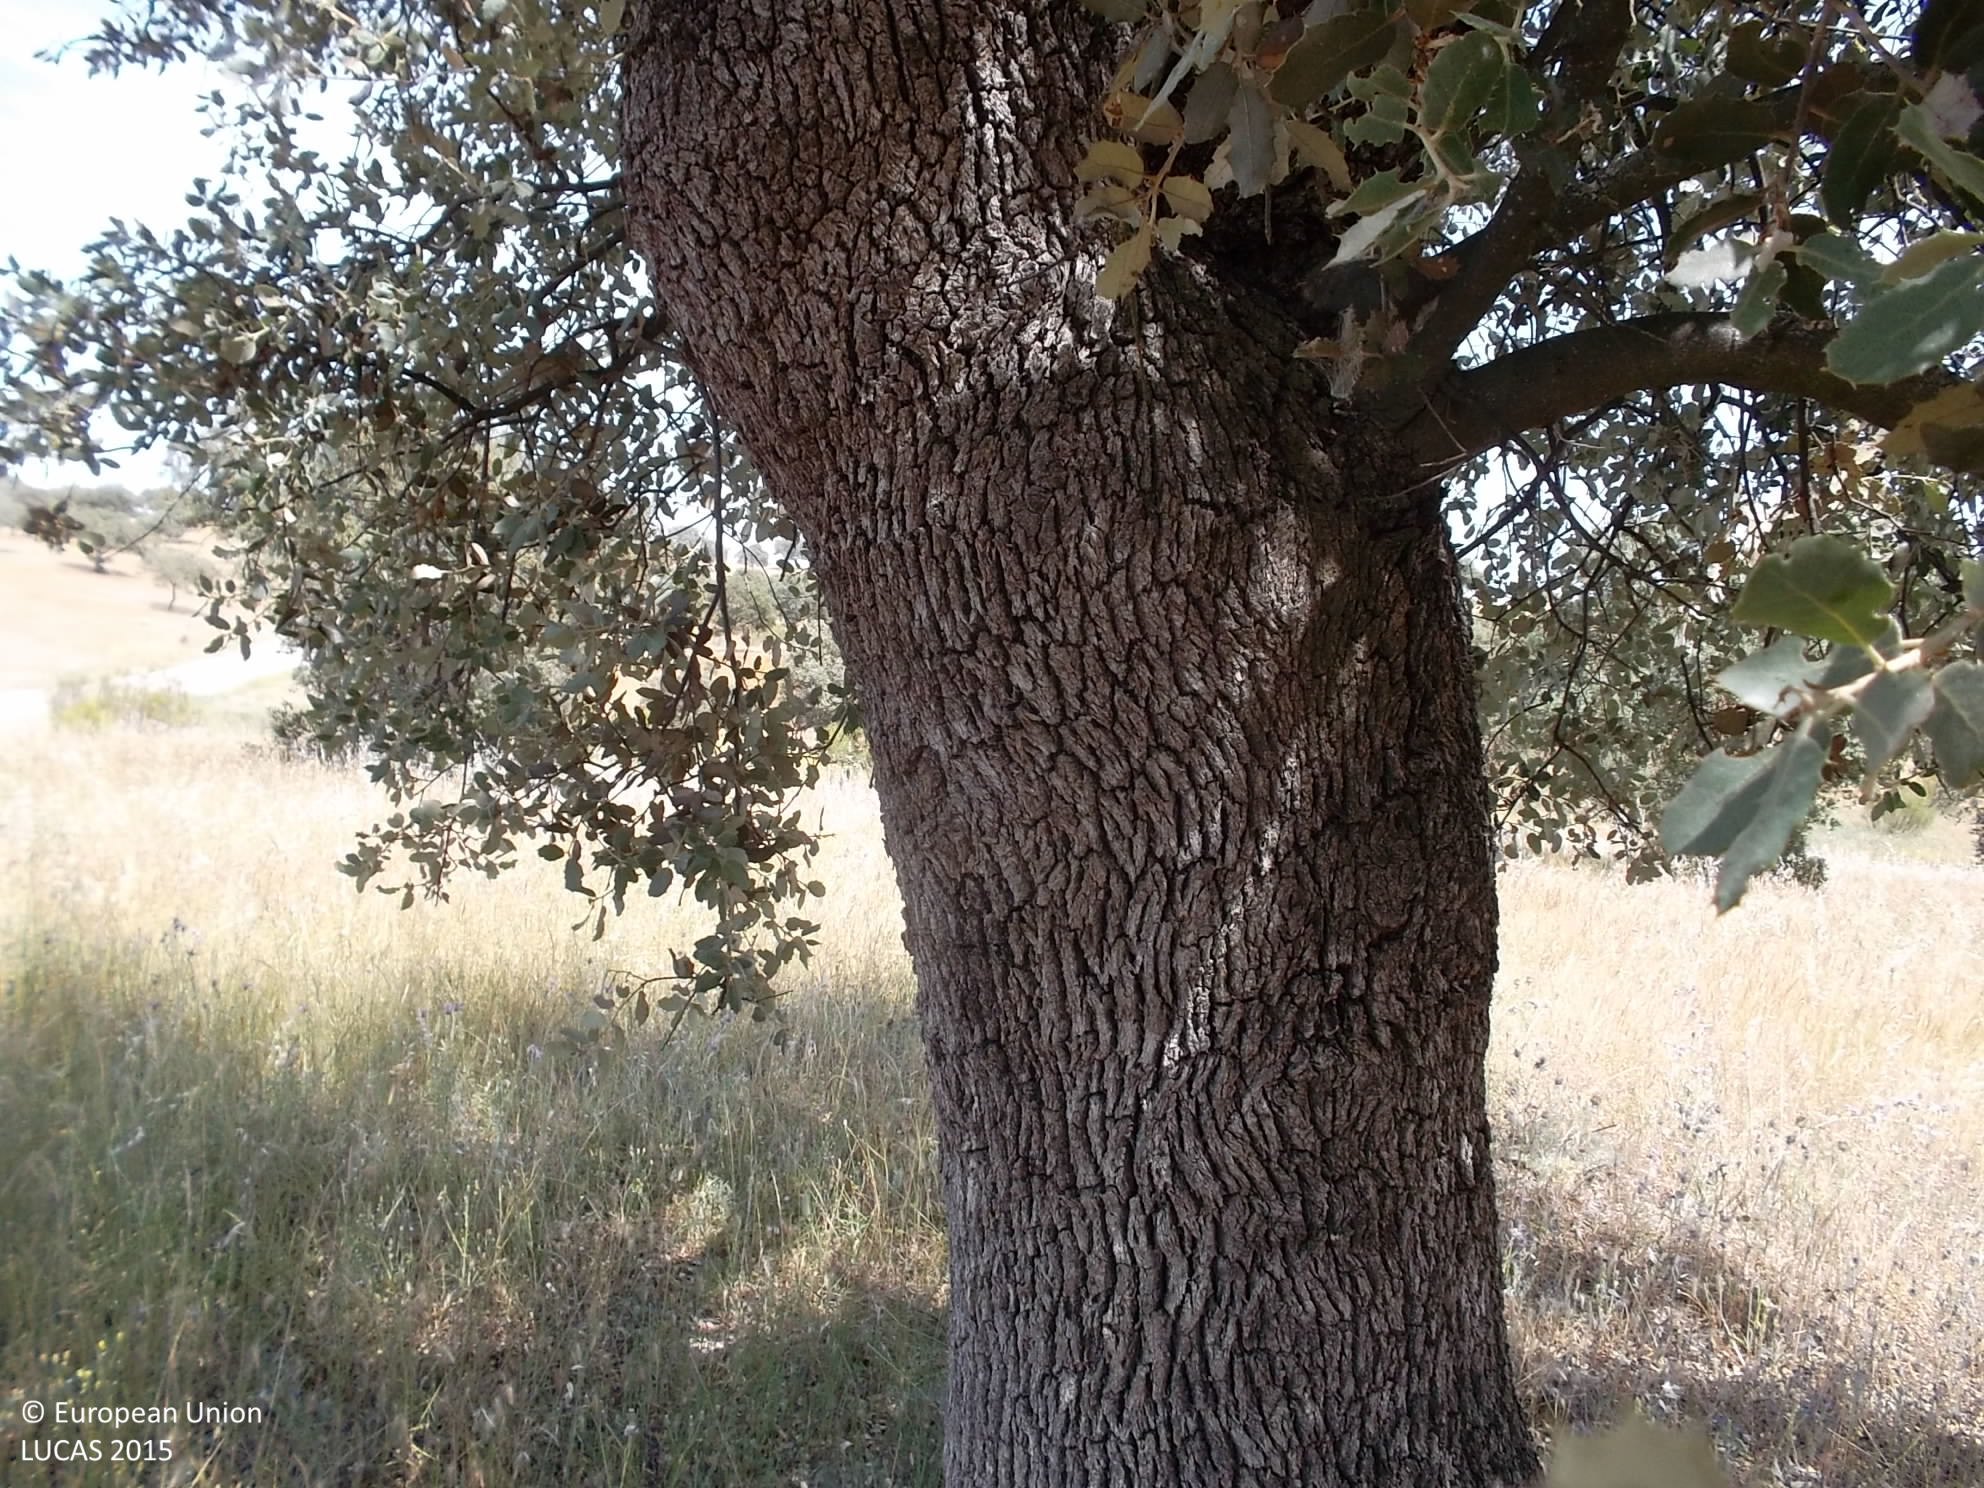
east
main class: Woodland
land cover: Broadleaved woodland
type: broadleaved evergreen forest
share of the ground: 25 - 50 %
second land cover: Spontaneously vegetated surfaces
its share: > 75 %
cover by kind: herbaceous plants 70 %, broadleaved forest trees 30 %
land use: Forestry
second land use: Agriculture (excluding fallow land and kitchen gardens)
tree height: > 5 m
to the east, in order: Broadleaved woodland; Spontaneously vegetated surfaces; Rivers and streams; Broadleaved woodland
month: May
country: ES
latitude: 38.6967
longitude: -4.8025
